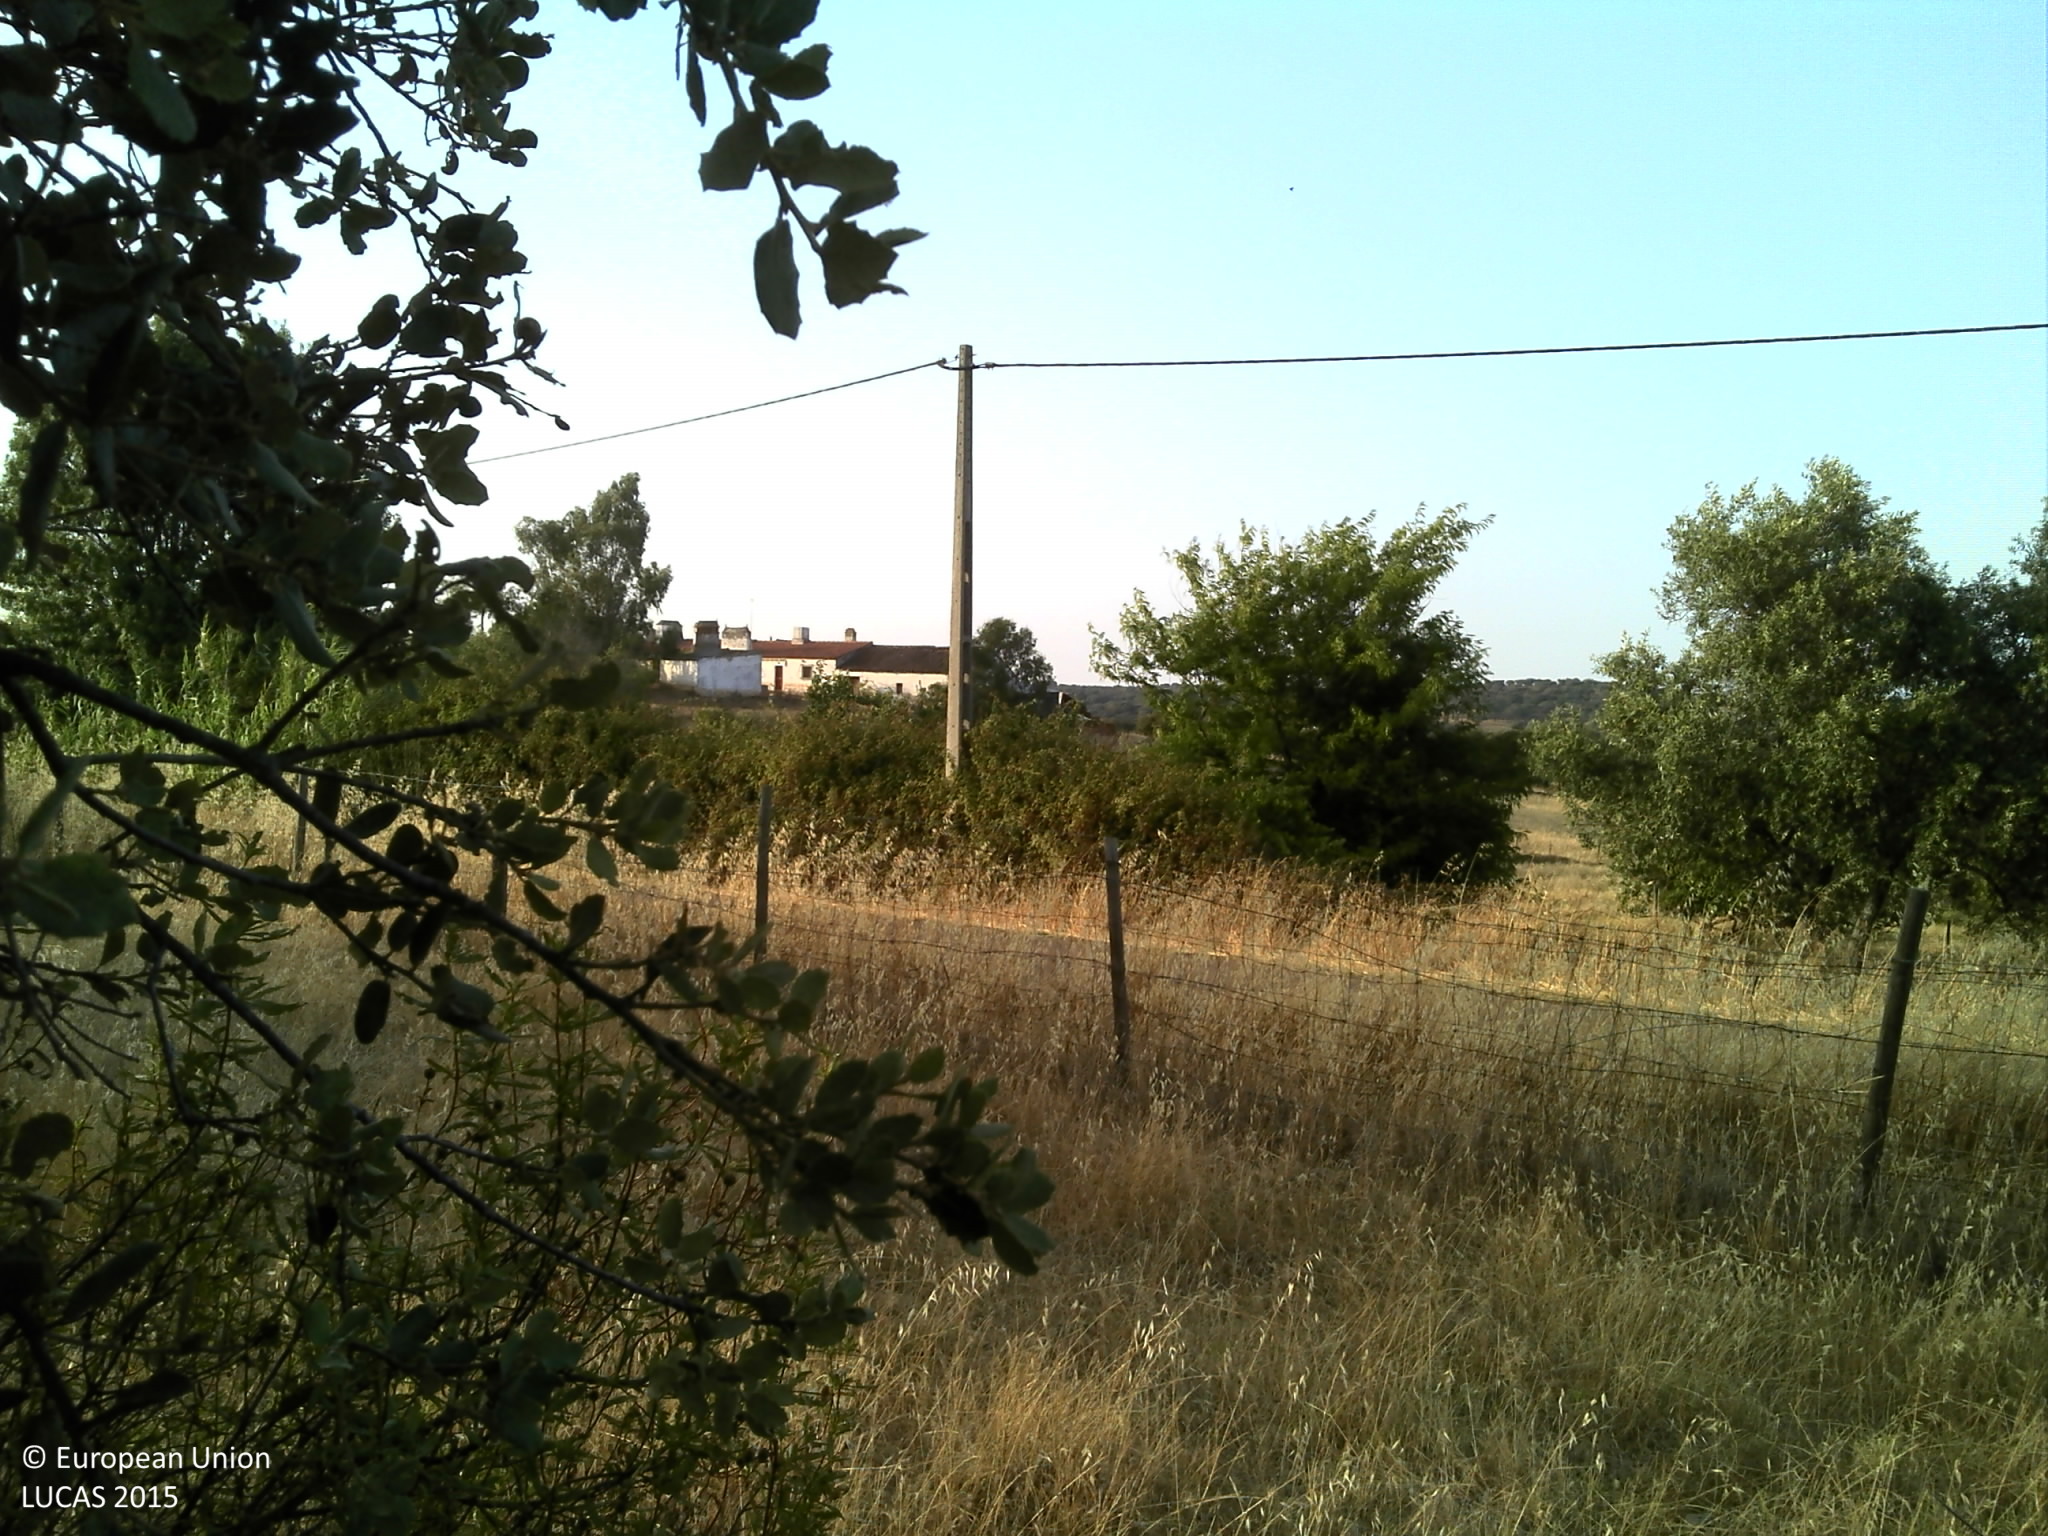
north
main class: Woodland
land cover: Broadleaved woodland
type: broadleaved evergreen forest
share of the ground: 10 - 25 %
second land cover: Grassland without tree/shrub cover
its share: 50 - 75 %
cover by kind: herbaceous plants 65 %, unconsolidated bare surface 20 %, broadleaved forest trees 10 %, shrubs 5 %
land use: Forestry
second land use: Agriculture (excluding fallow land and kitchen gardens)
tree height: < 5 m
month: July
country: PT
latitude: 38.6848
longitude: -7.3764
